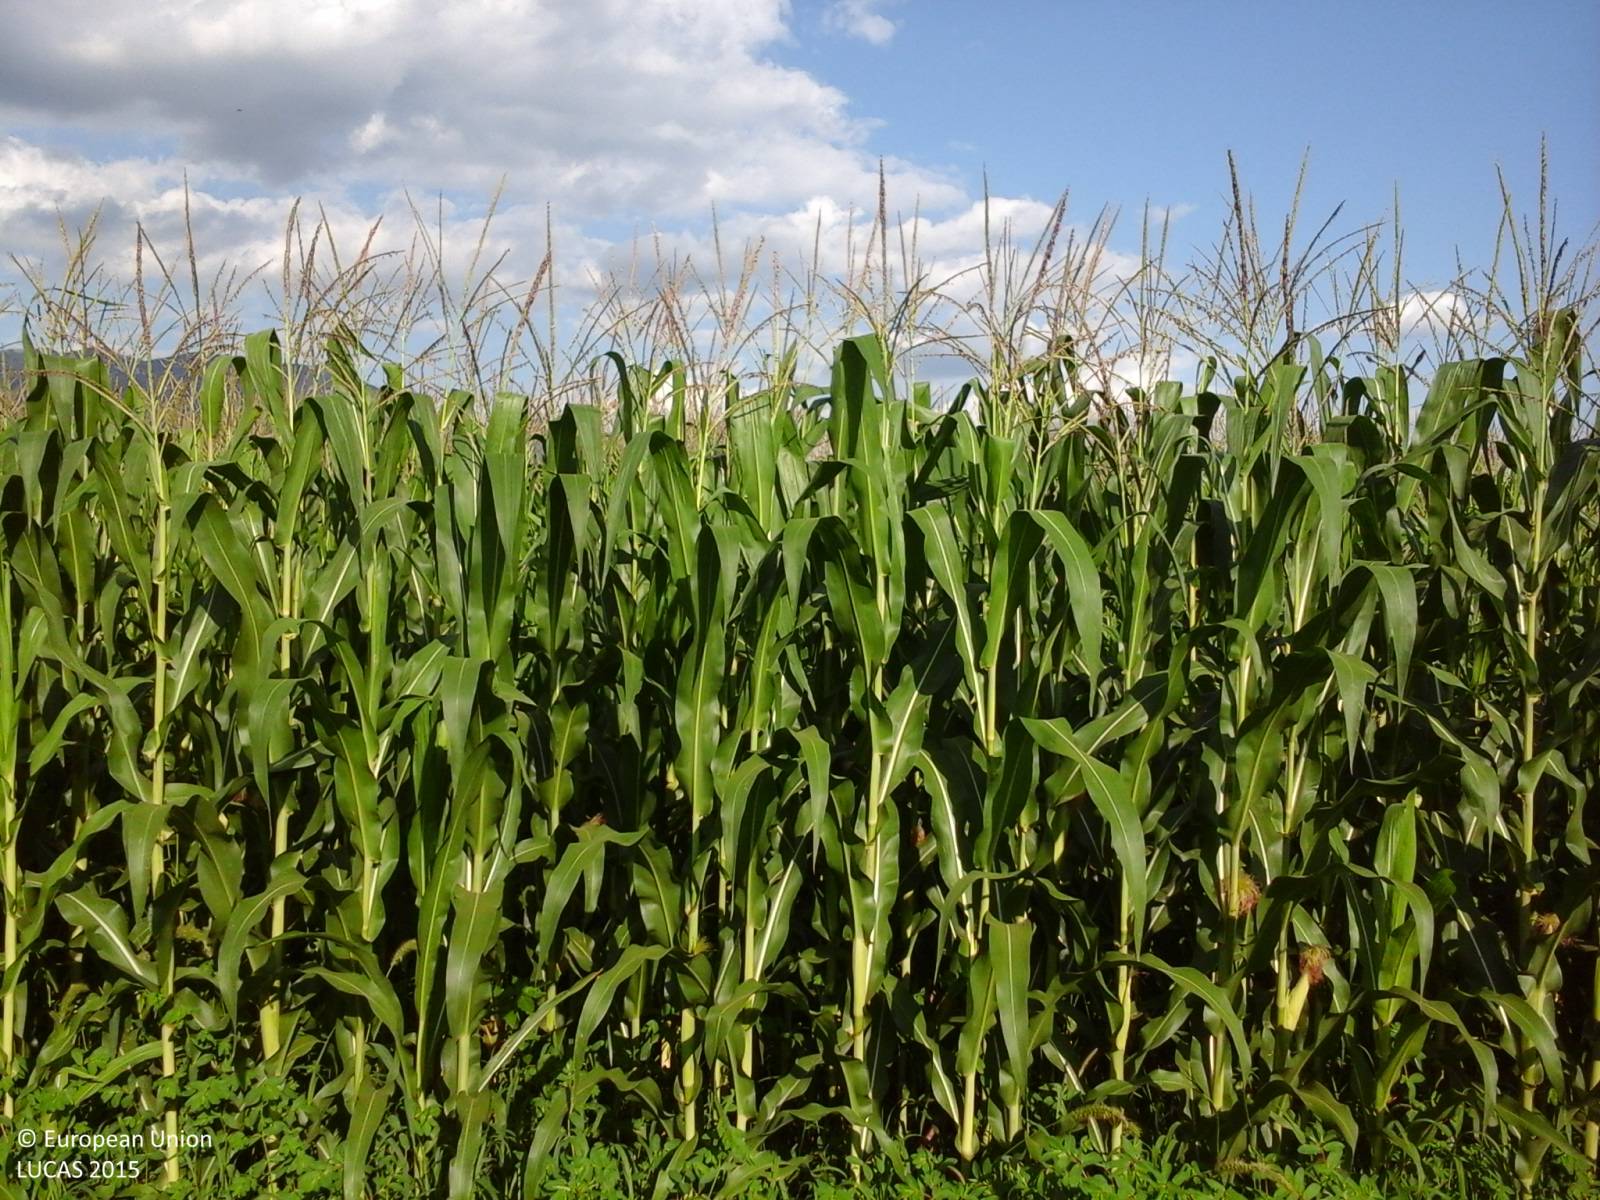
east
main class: Cropland
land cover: Maize
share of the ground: > 75 %
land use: Agriculture (excluding fallow land and kitchen gardens)
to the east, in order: Maize; Grass margins; Paved roads, cycling and walking lanes; Electric lines; Grass margins; Maize; Grass margins; Railways; Grass margins; Other bare soil
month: August
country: IT
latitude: 41.3304
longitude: 14.3448
